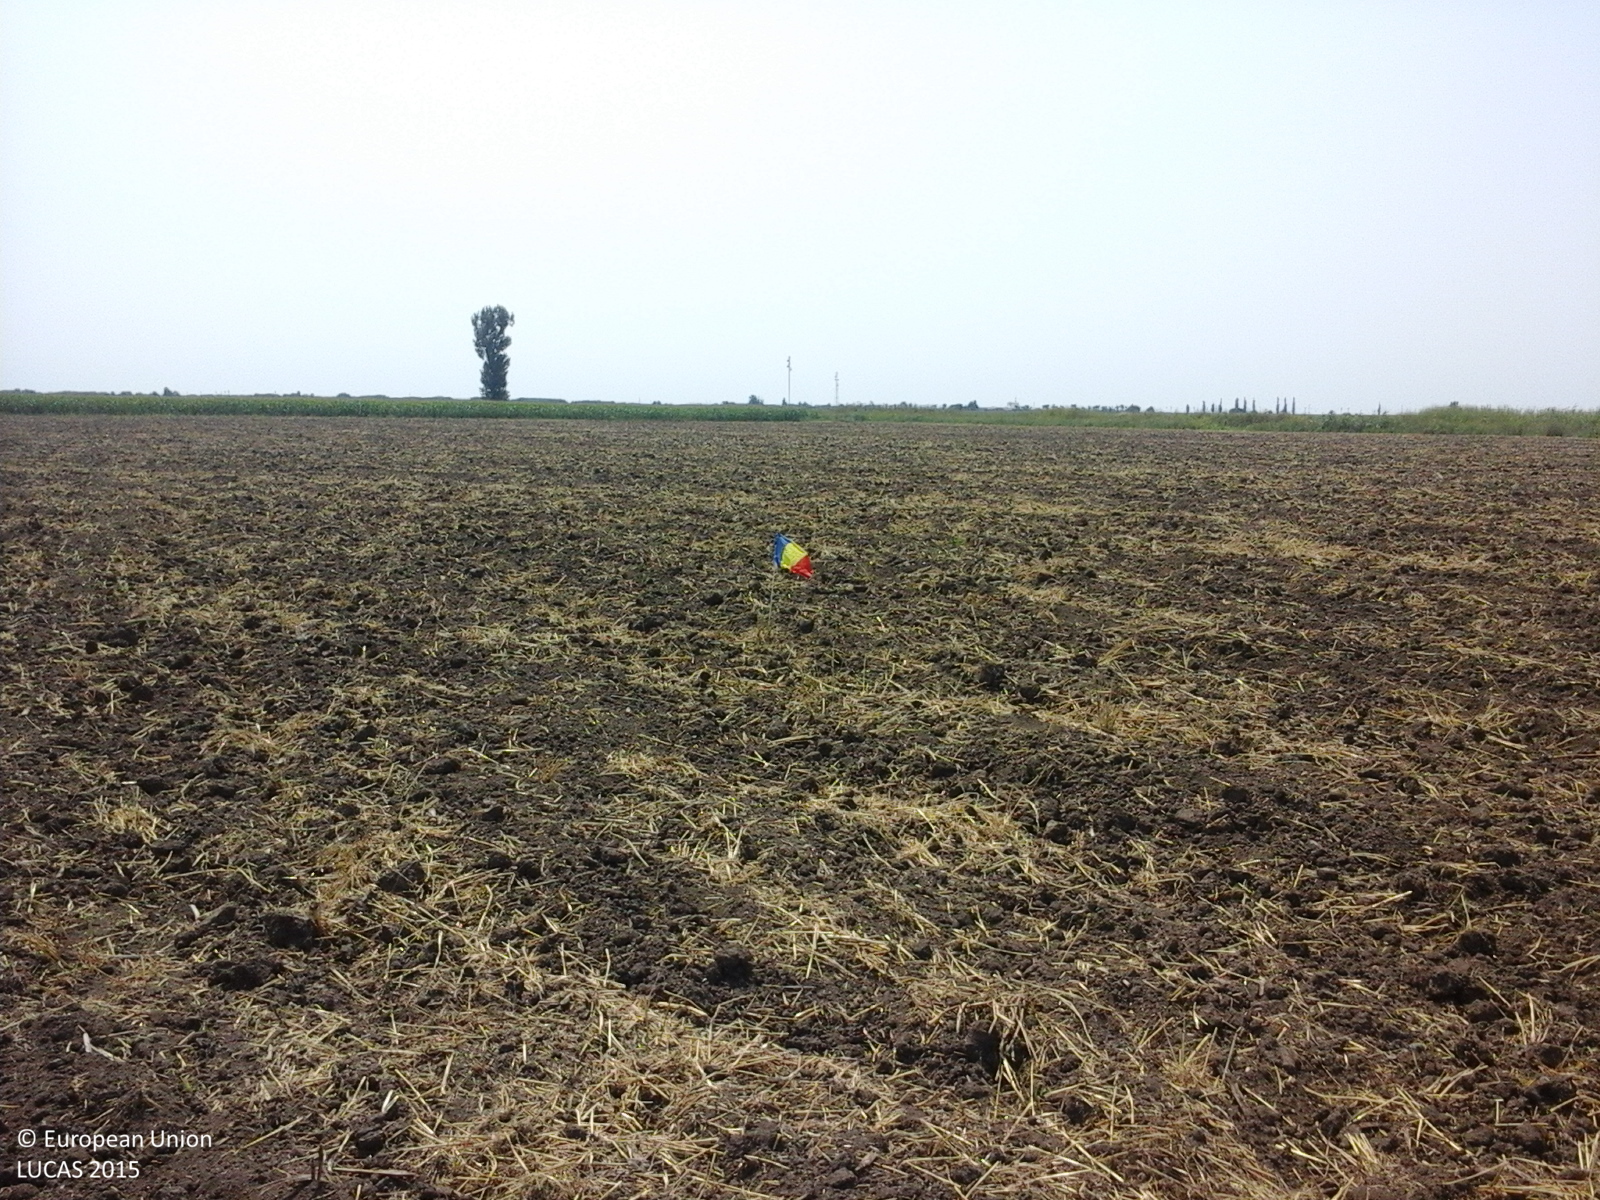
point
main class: Cropland
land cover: Common wheat
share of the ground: < 10 %
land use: Agriculture (excluding fallow land and kitchen gardens)
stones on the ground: < 10 %
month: July
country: RO
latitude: 44.5271
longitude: 26.7183
